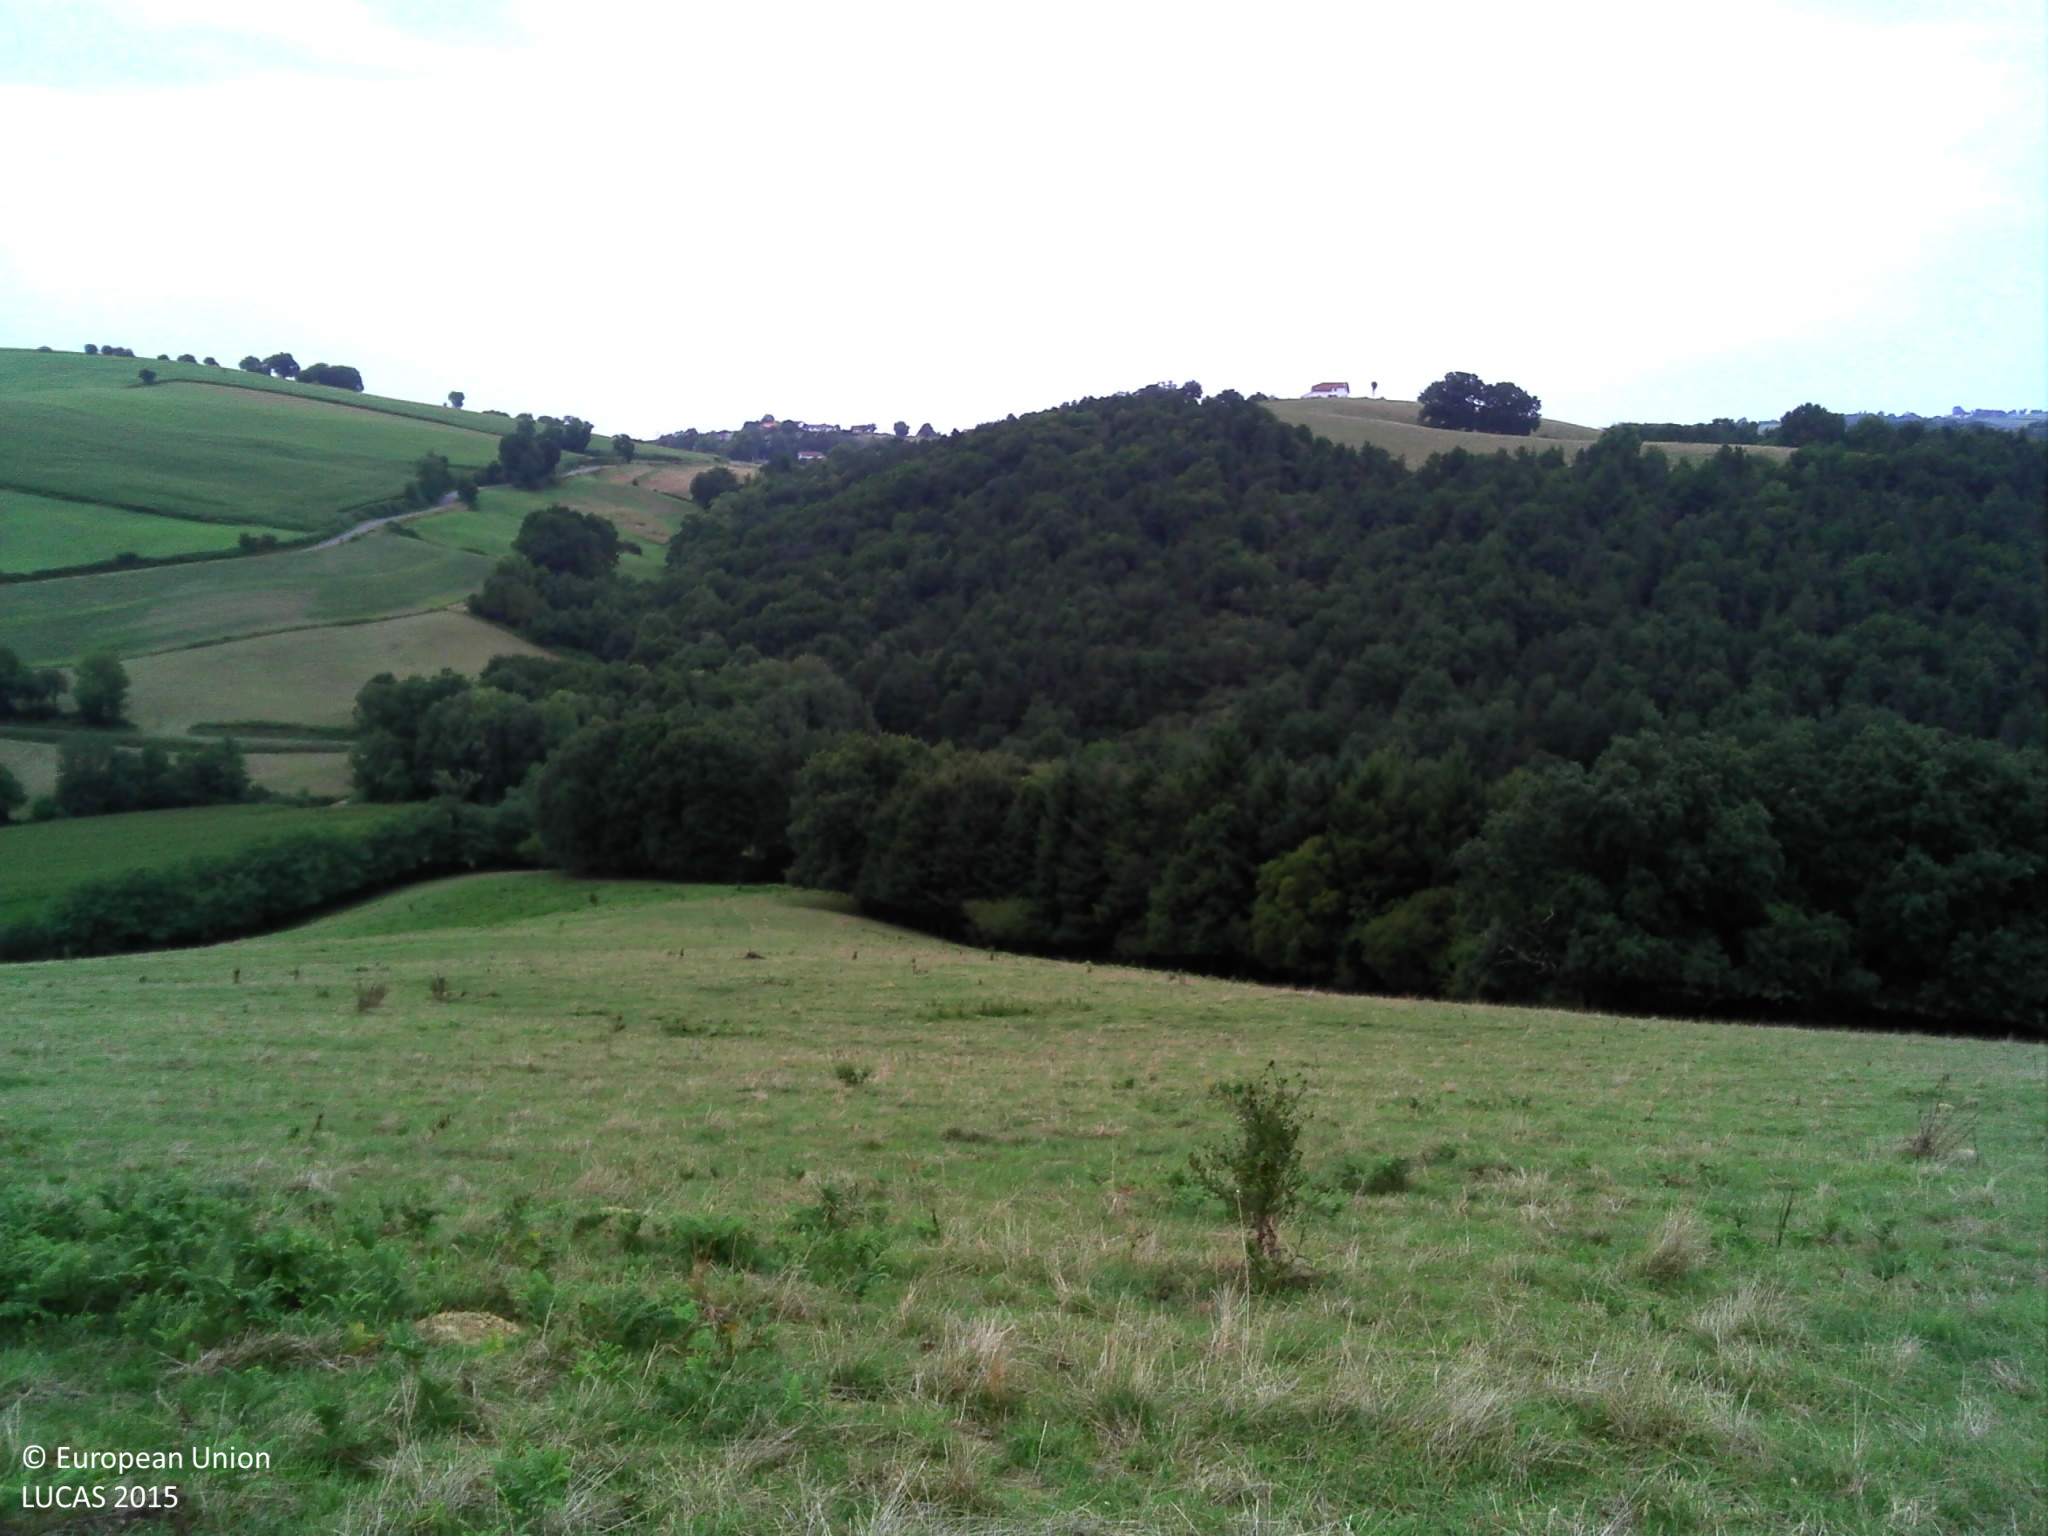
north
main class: Grassland
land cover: Grassland without tree/shrub cover
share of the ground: > 75 %
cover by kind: herbaceous plants 100 %
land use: Agriculture (excluding fallow land and kitchen gardens)
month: August
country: FR
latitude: 43.4458
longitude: -1.2476
